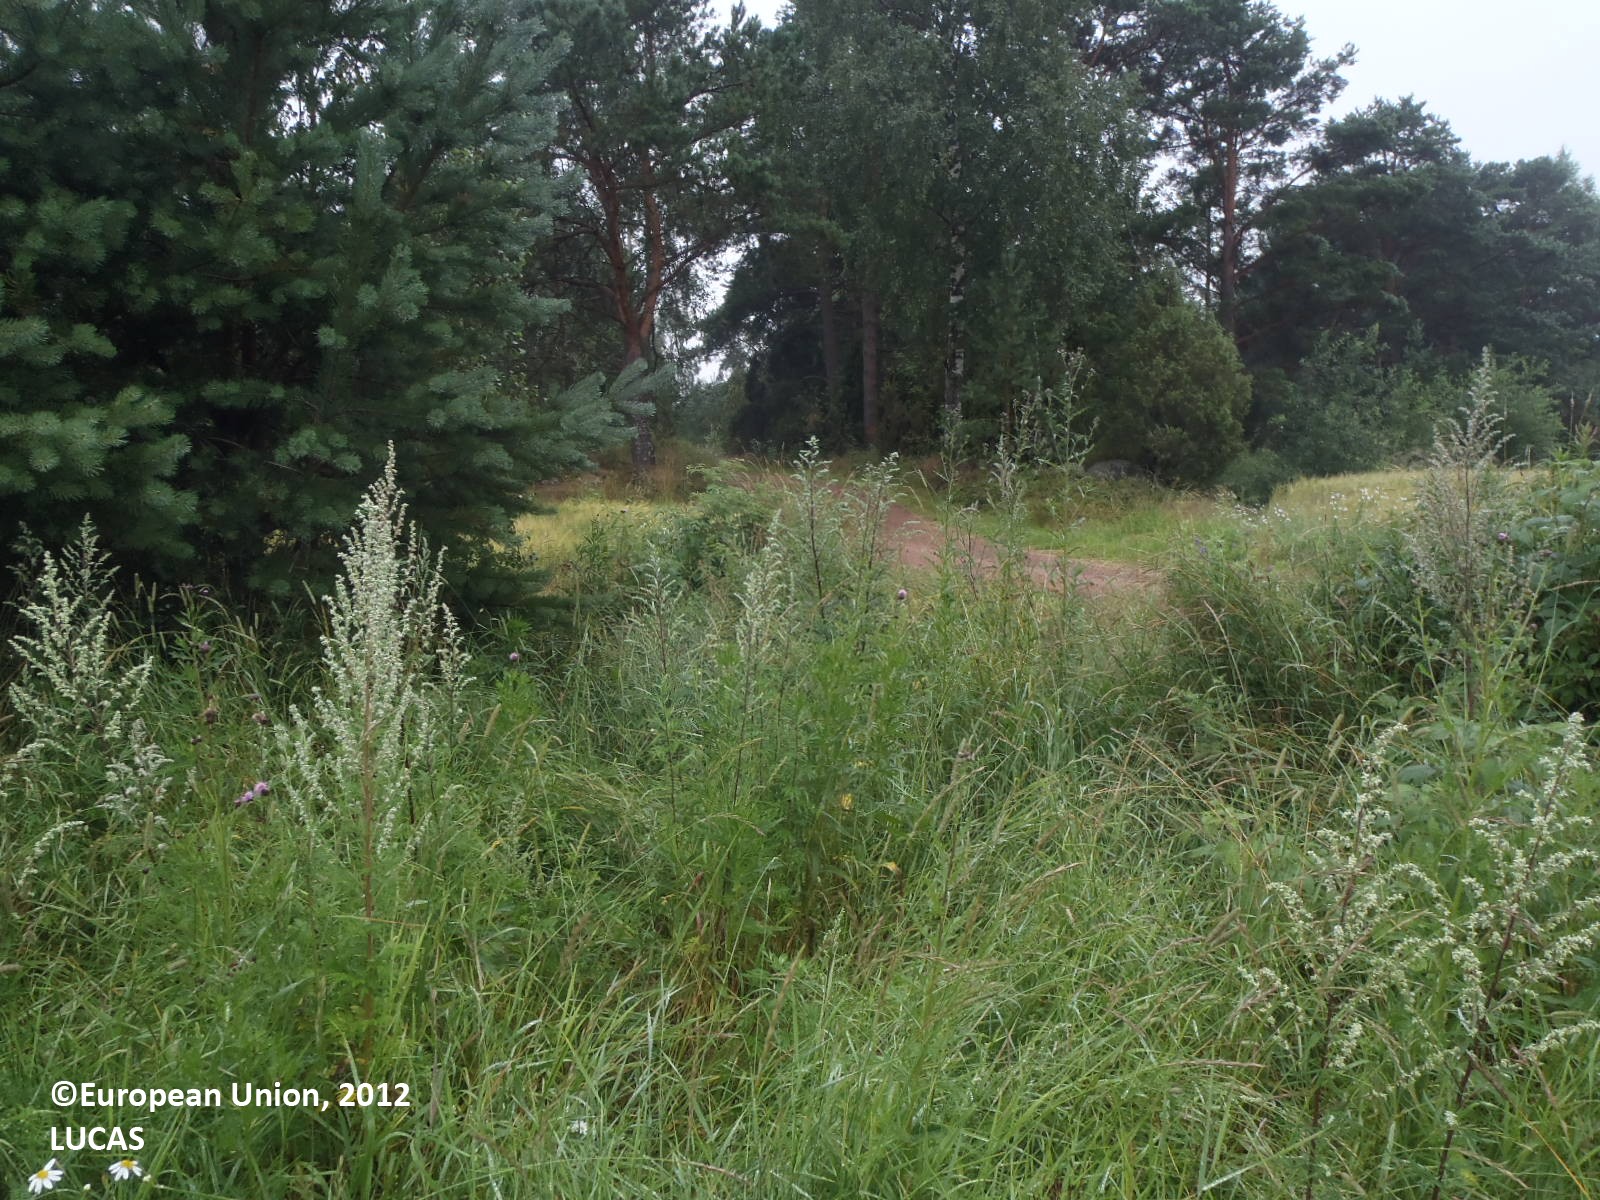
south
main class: Cropland
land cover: Oats
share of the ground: > 75 %
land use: Agriculture (excluding fallow land and kitchen gardens)
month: July
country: FI
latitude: 60.6896
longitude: 21.7605
